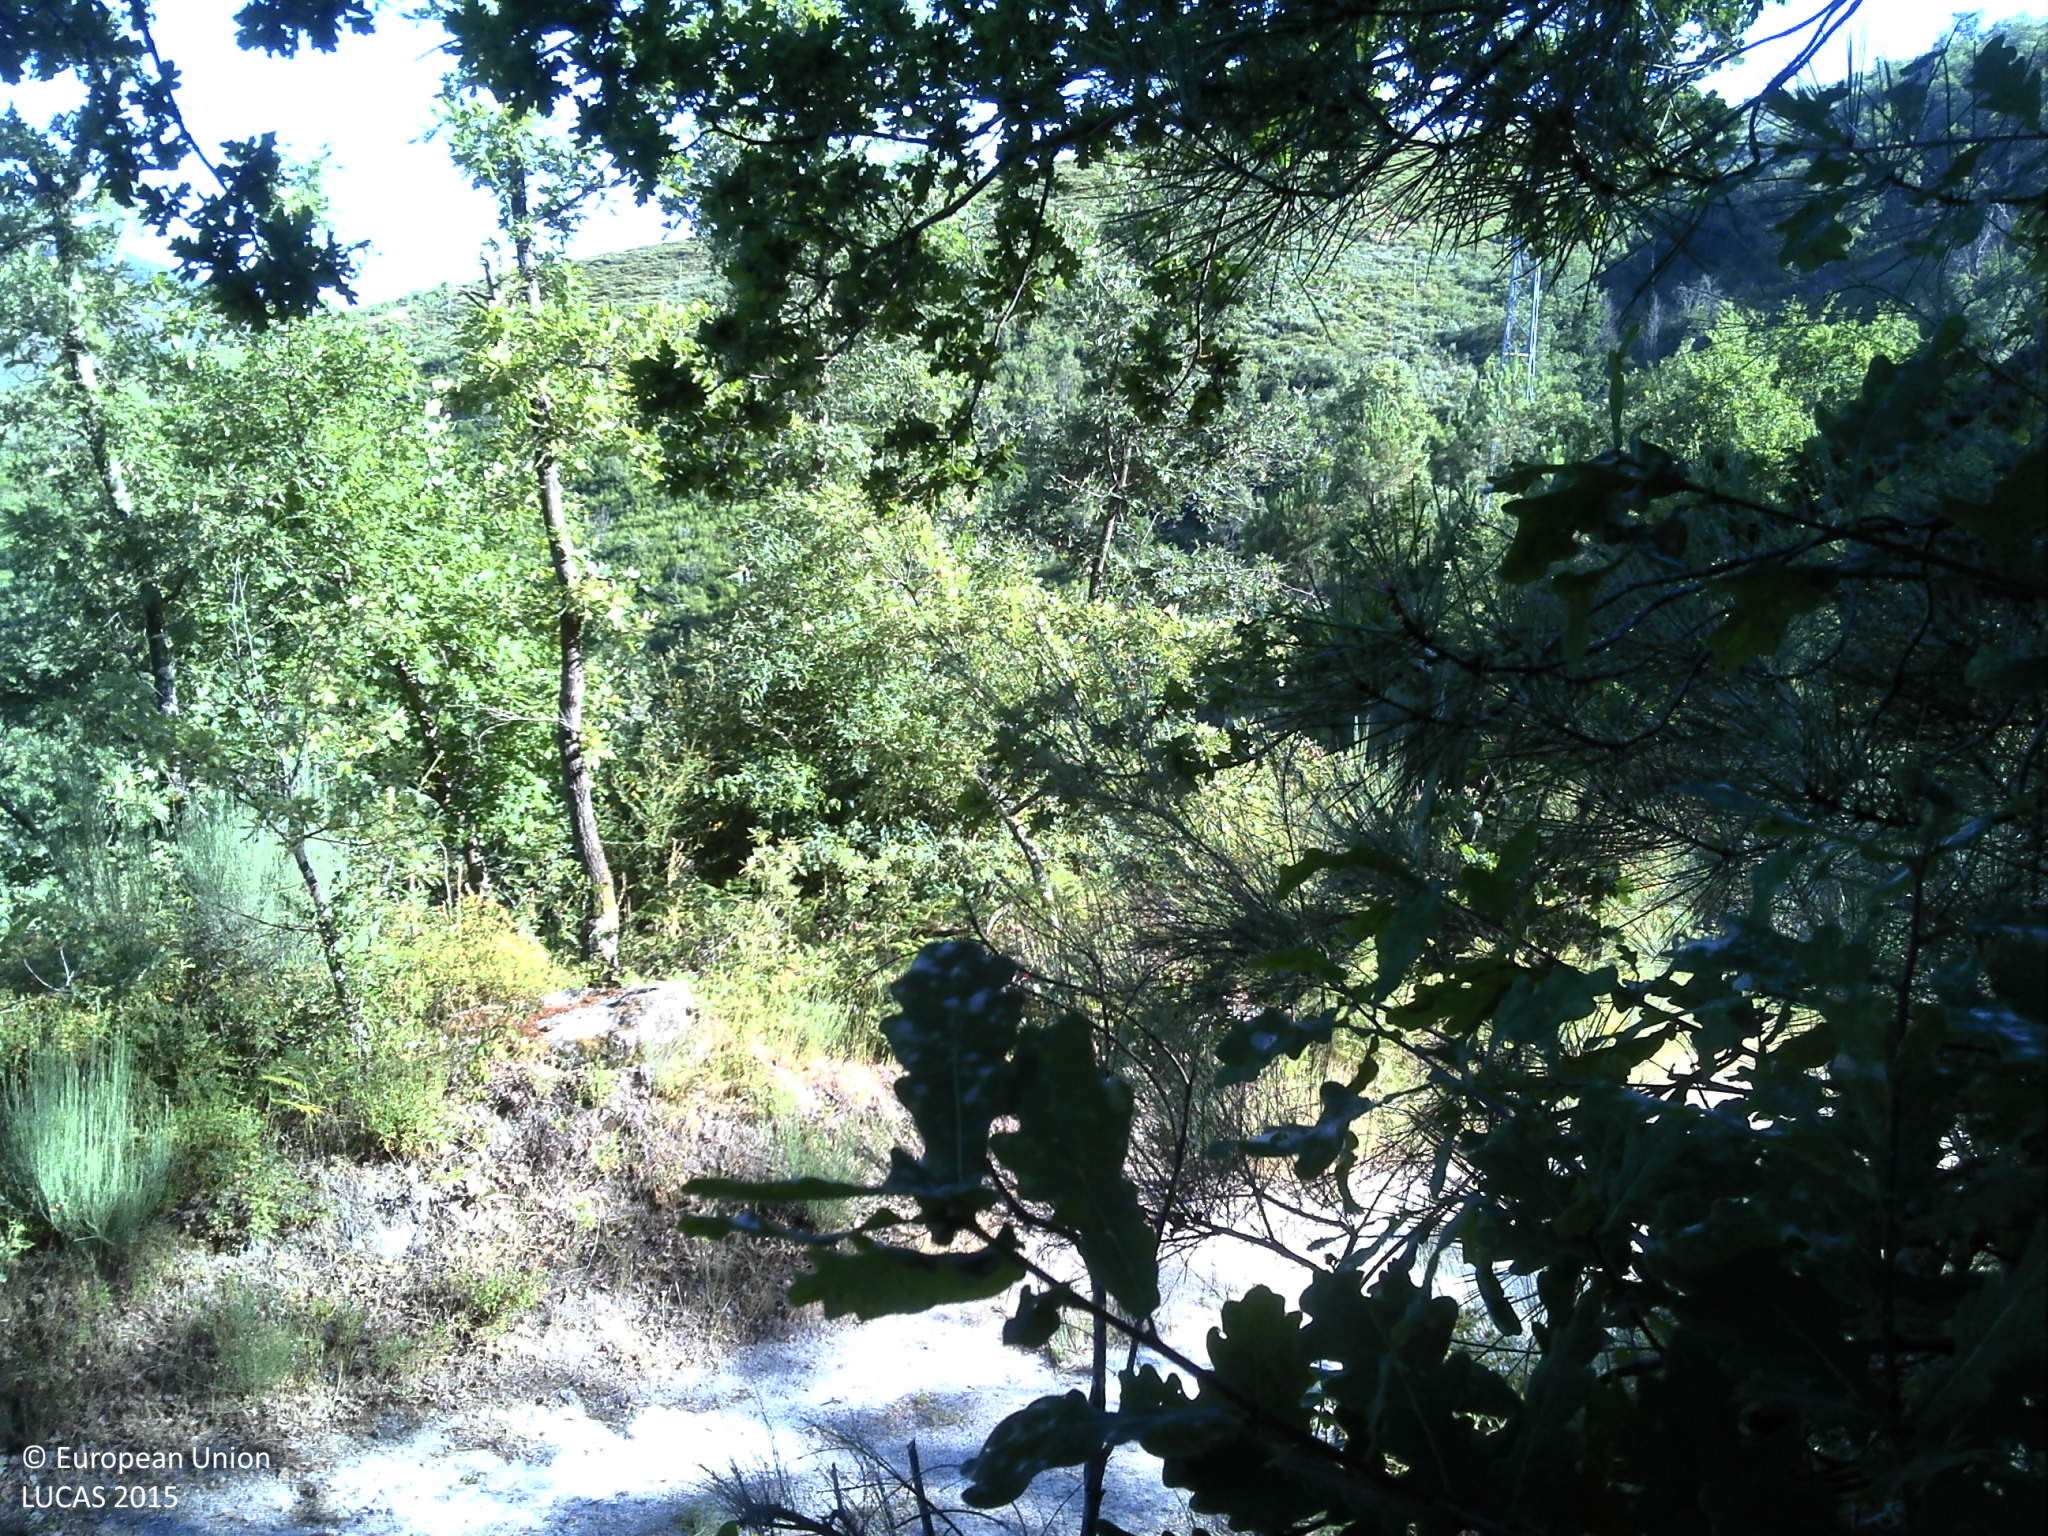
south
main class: Woodland
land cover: Broadleaved woodland
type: thermophilous deciduous forest
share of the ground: > 75 %
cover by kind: broadleaved forest trees 75 %, shrubs 10 %, unconsolidated bare surface 10 %, herbaceous plants 5 %
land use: Forestry
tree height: > 5 m
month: July
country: PT
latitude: 41.6260
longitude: -7.7438
